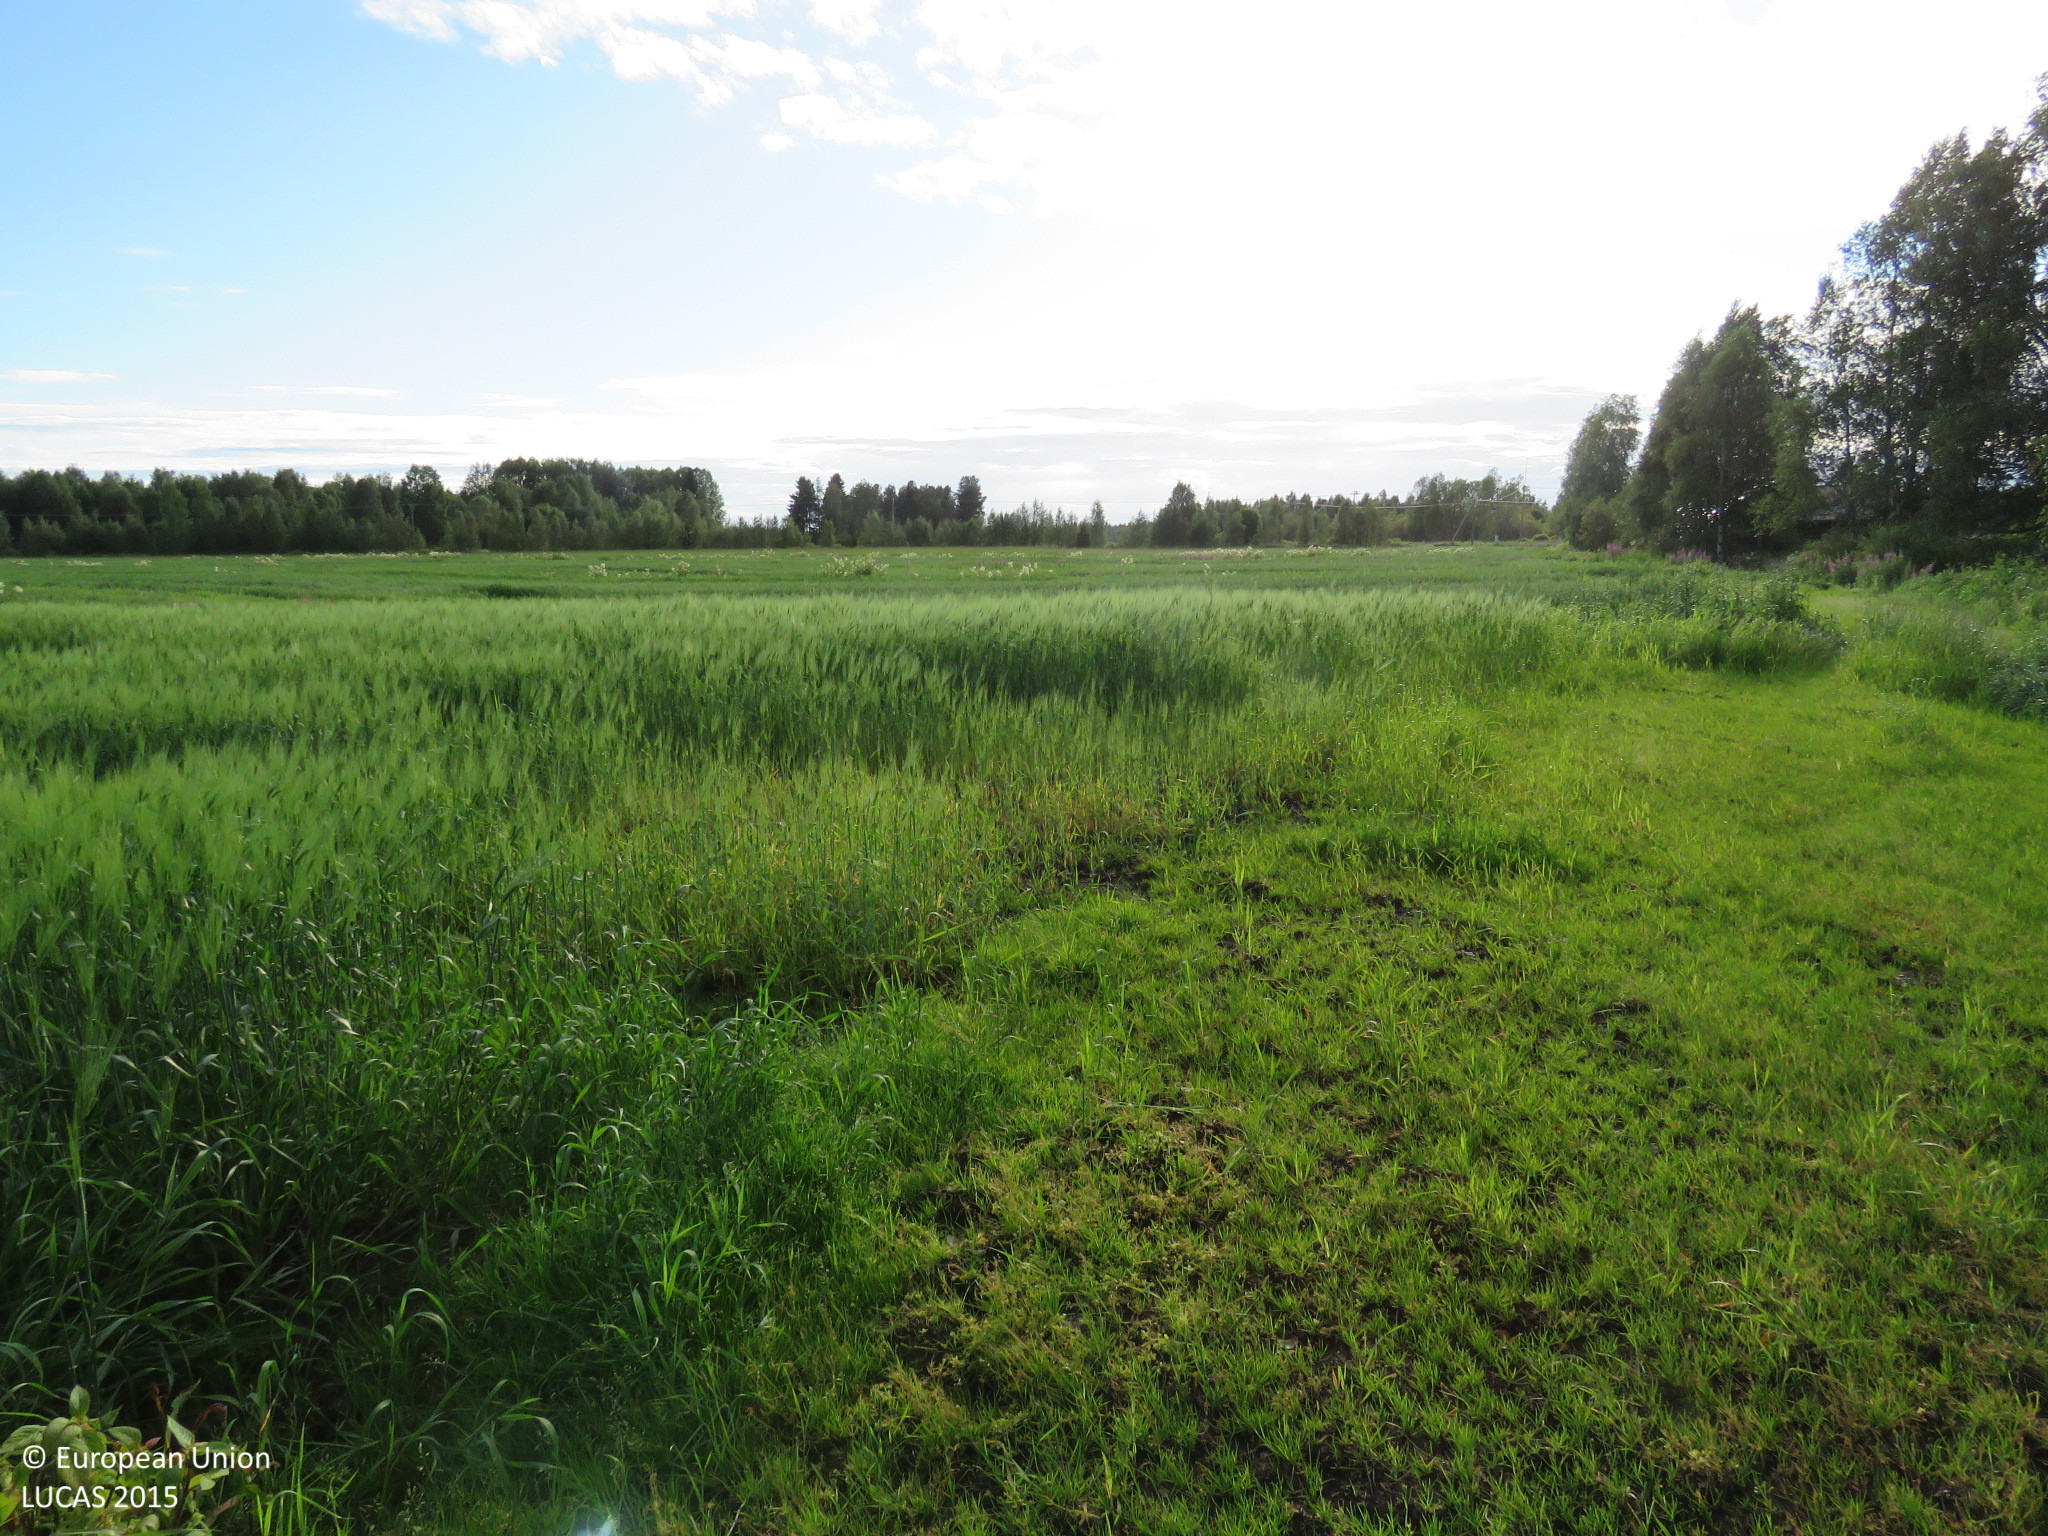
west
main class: Grassland
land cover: Spontaneously vegetated surfaces
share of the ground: 10 - 25 %
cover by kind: unconsolidated bare surface 90 %, herbaceous plants 10 %
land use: Fallow land
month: July
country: FI
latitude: 64.7600
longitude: 26.3978
